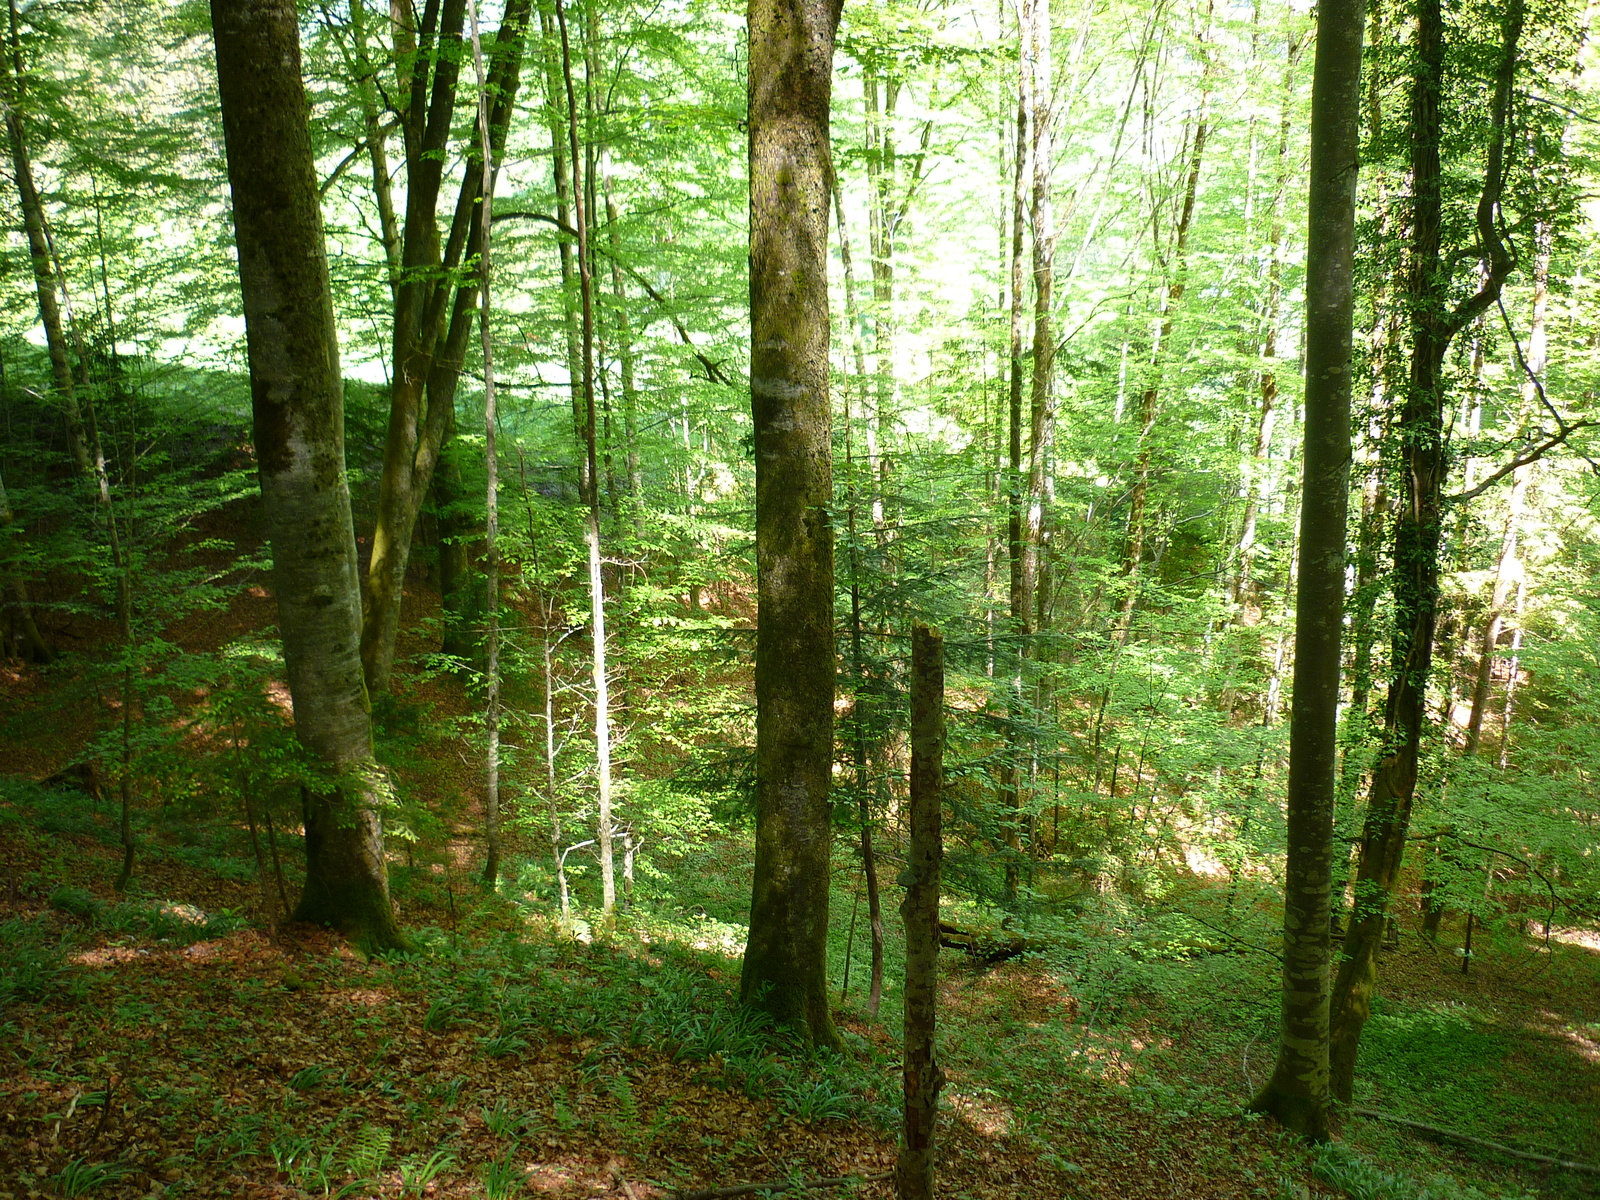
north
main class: Woodland
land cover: Broadleaved woodland
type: mountainous beech forest
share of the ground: > 75 %
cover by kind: broadleaved forest trees 85 %, coniferous forest trees 10 %, herbaceous plants 5 %
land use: Forestry
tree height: > 5 m
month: May
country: AT
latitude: 47.6692
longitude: 14.7810
